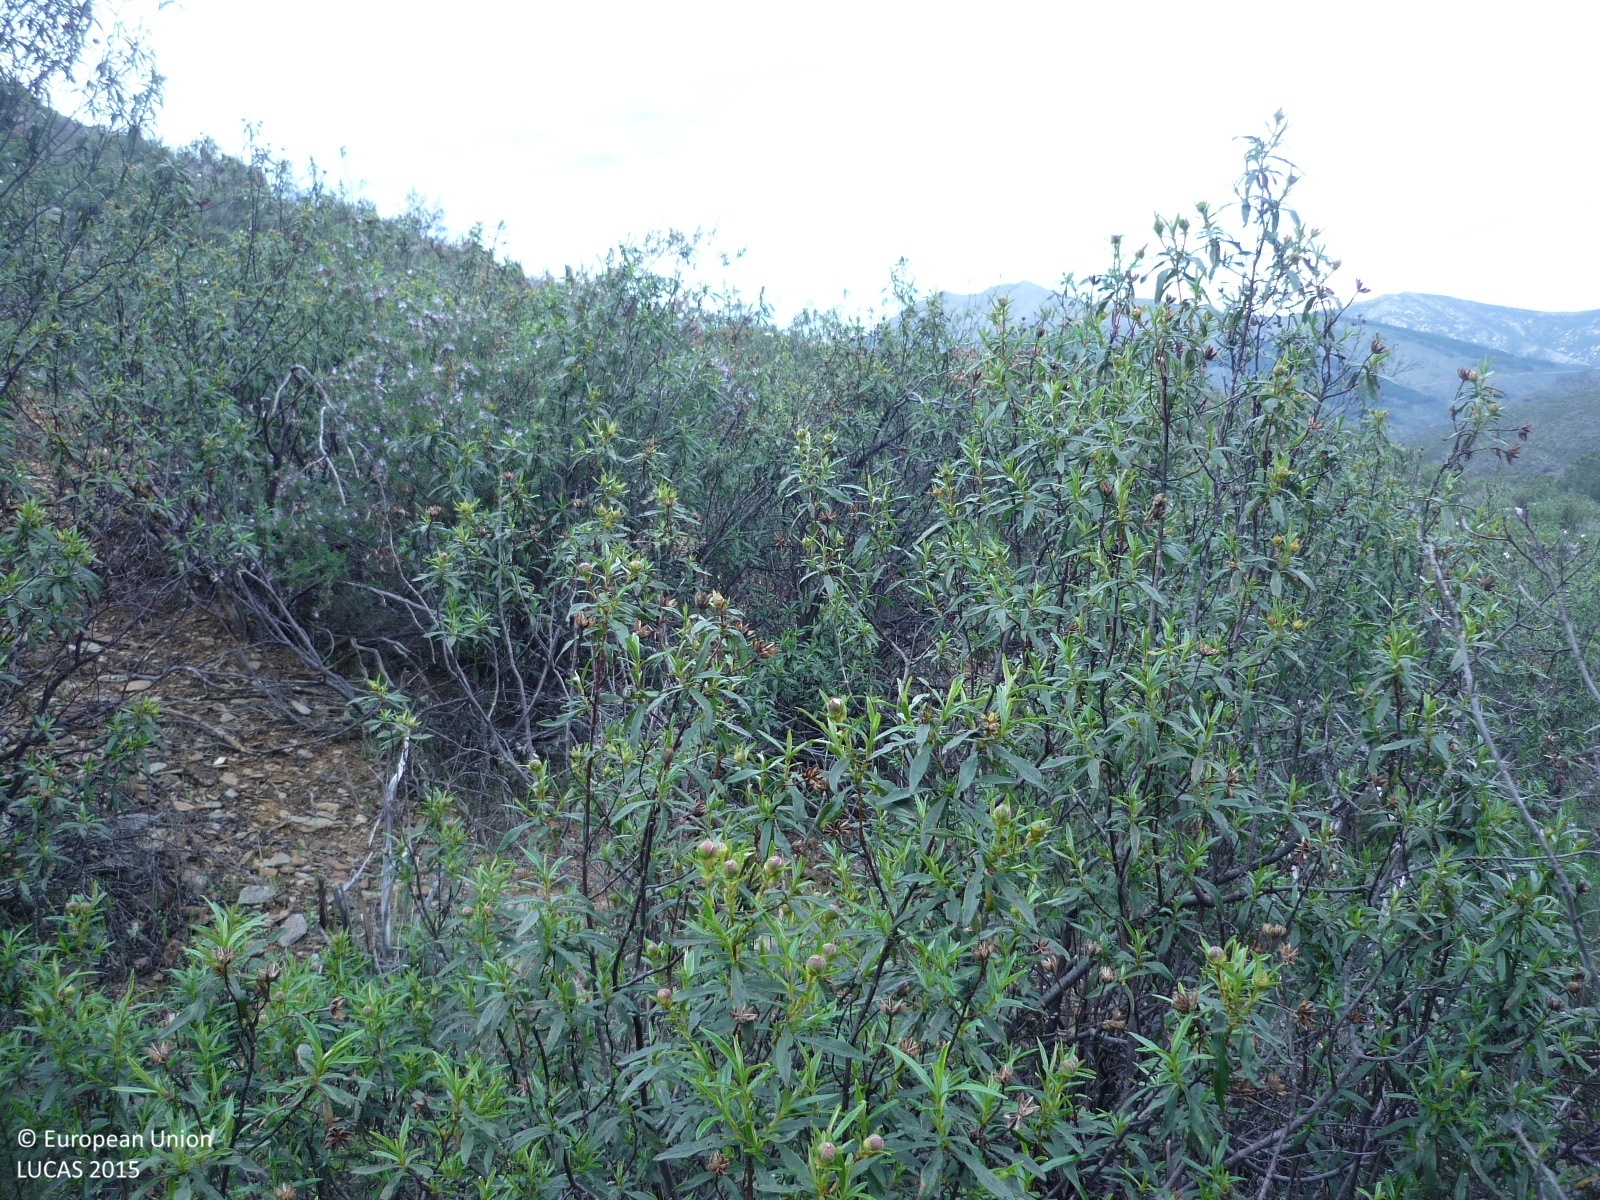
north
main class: Shrubland
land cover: Shrubland with sparse tree cover
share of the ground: > 75 %
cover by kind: shrubs 85 %, herbaceous plants 10 %, coniferous forest trees 5 %
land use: Semi-natural and natural areas not in use
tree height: > 5 m
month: April
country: ES
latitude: 40.9408
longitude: -3.4990
